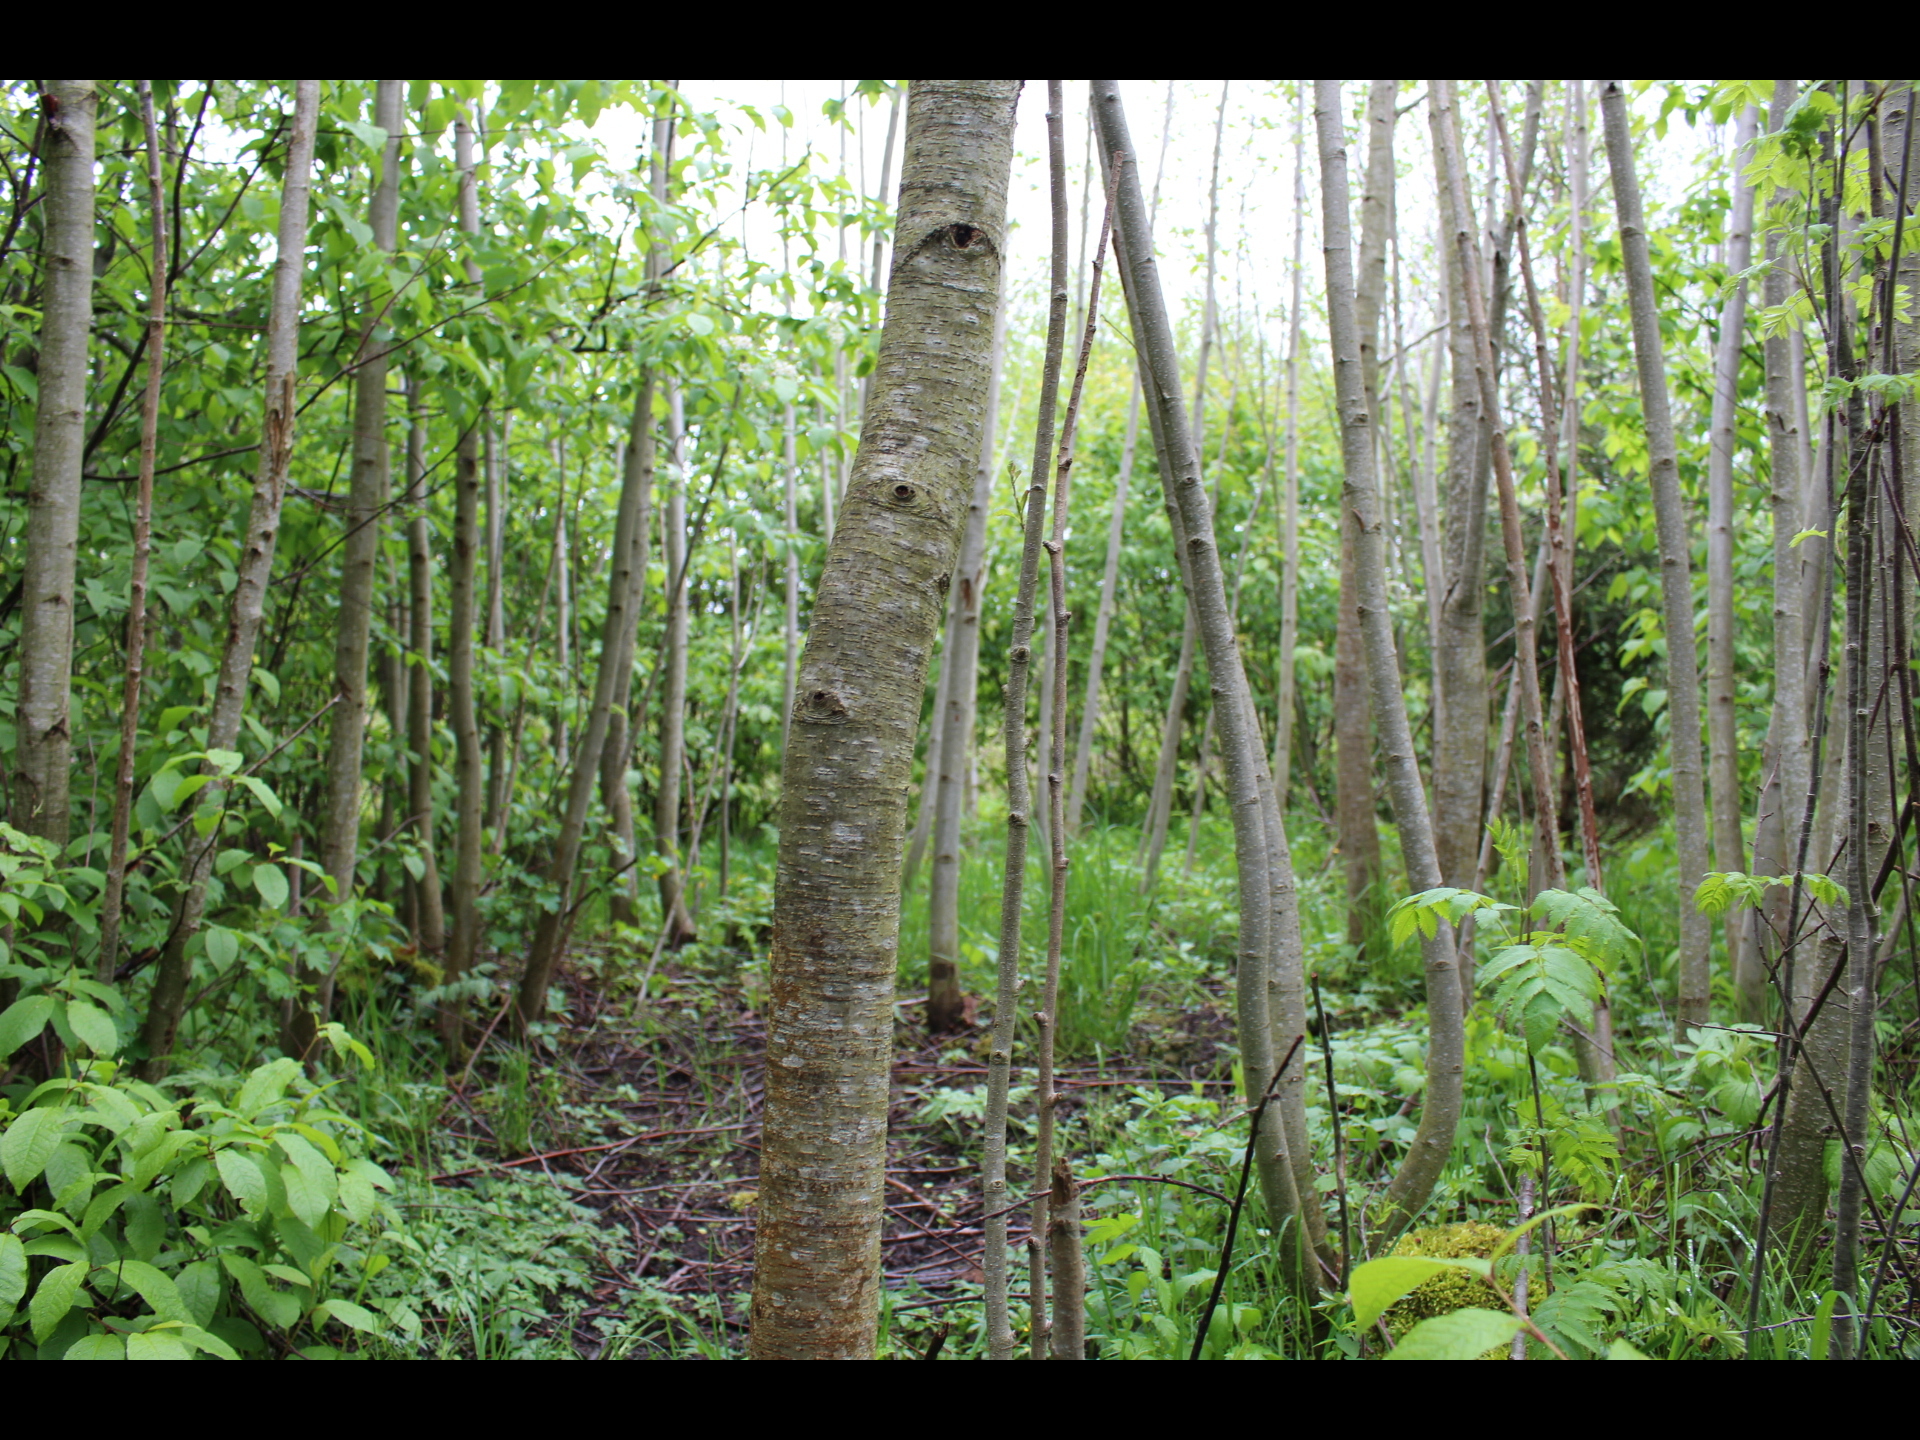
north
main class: Woodland
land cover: Broadleaved woodland
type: non-riverine alder, birch or aspen forest
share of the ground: > 75 %
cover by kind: broadleaved forest trees 95 %, herbaceous plants 5 %
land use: Forestry
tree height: < 5 m
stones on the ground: < 10 %
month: May
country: LV
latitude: 56.8319
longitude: 22.8616
